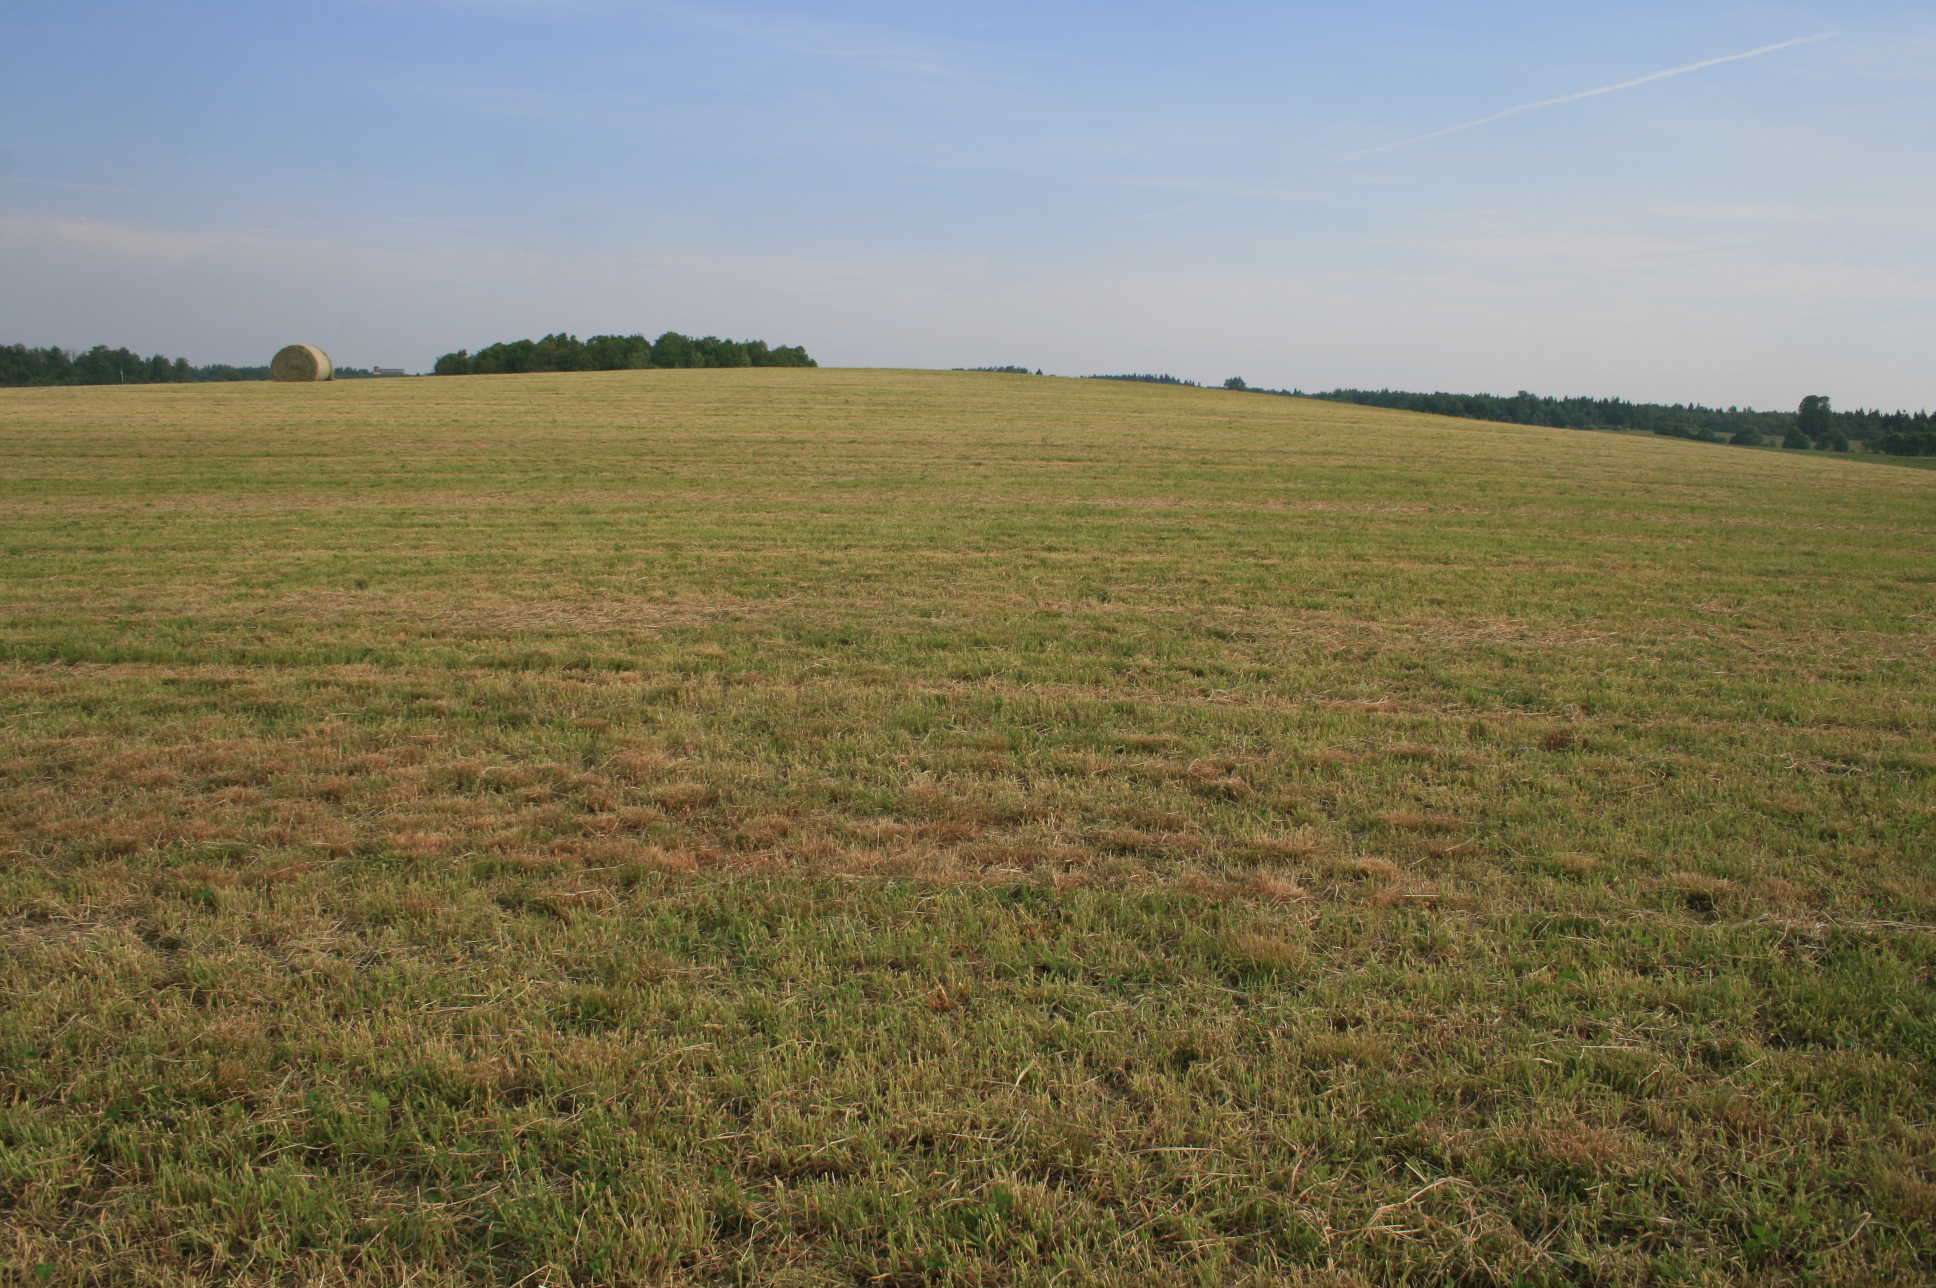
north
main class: Grassland
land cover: Grassland without tree/shrub cover
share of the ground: > 75 %
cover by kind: herbaceous plants 100 %
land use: Agriculture (excluding fallow land and kitchen gardens)
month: June
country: LT
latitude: 55.7269
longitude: 22.2367
